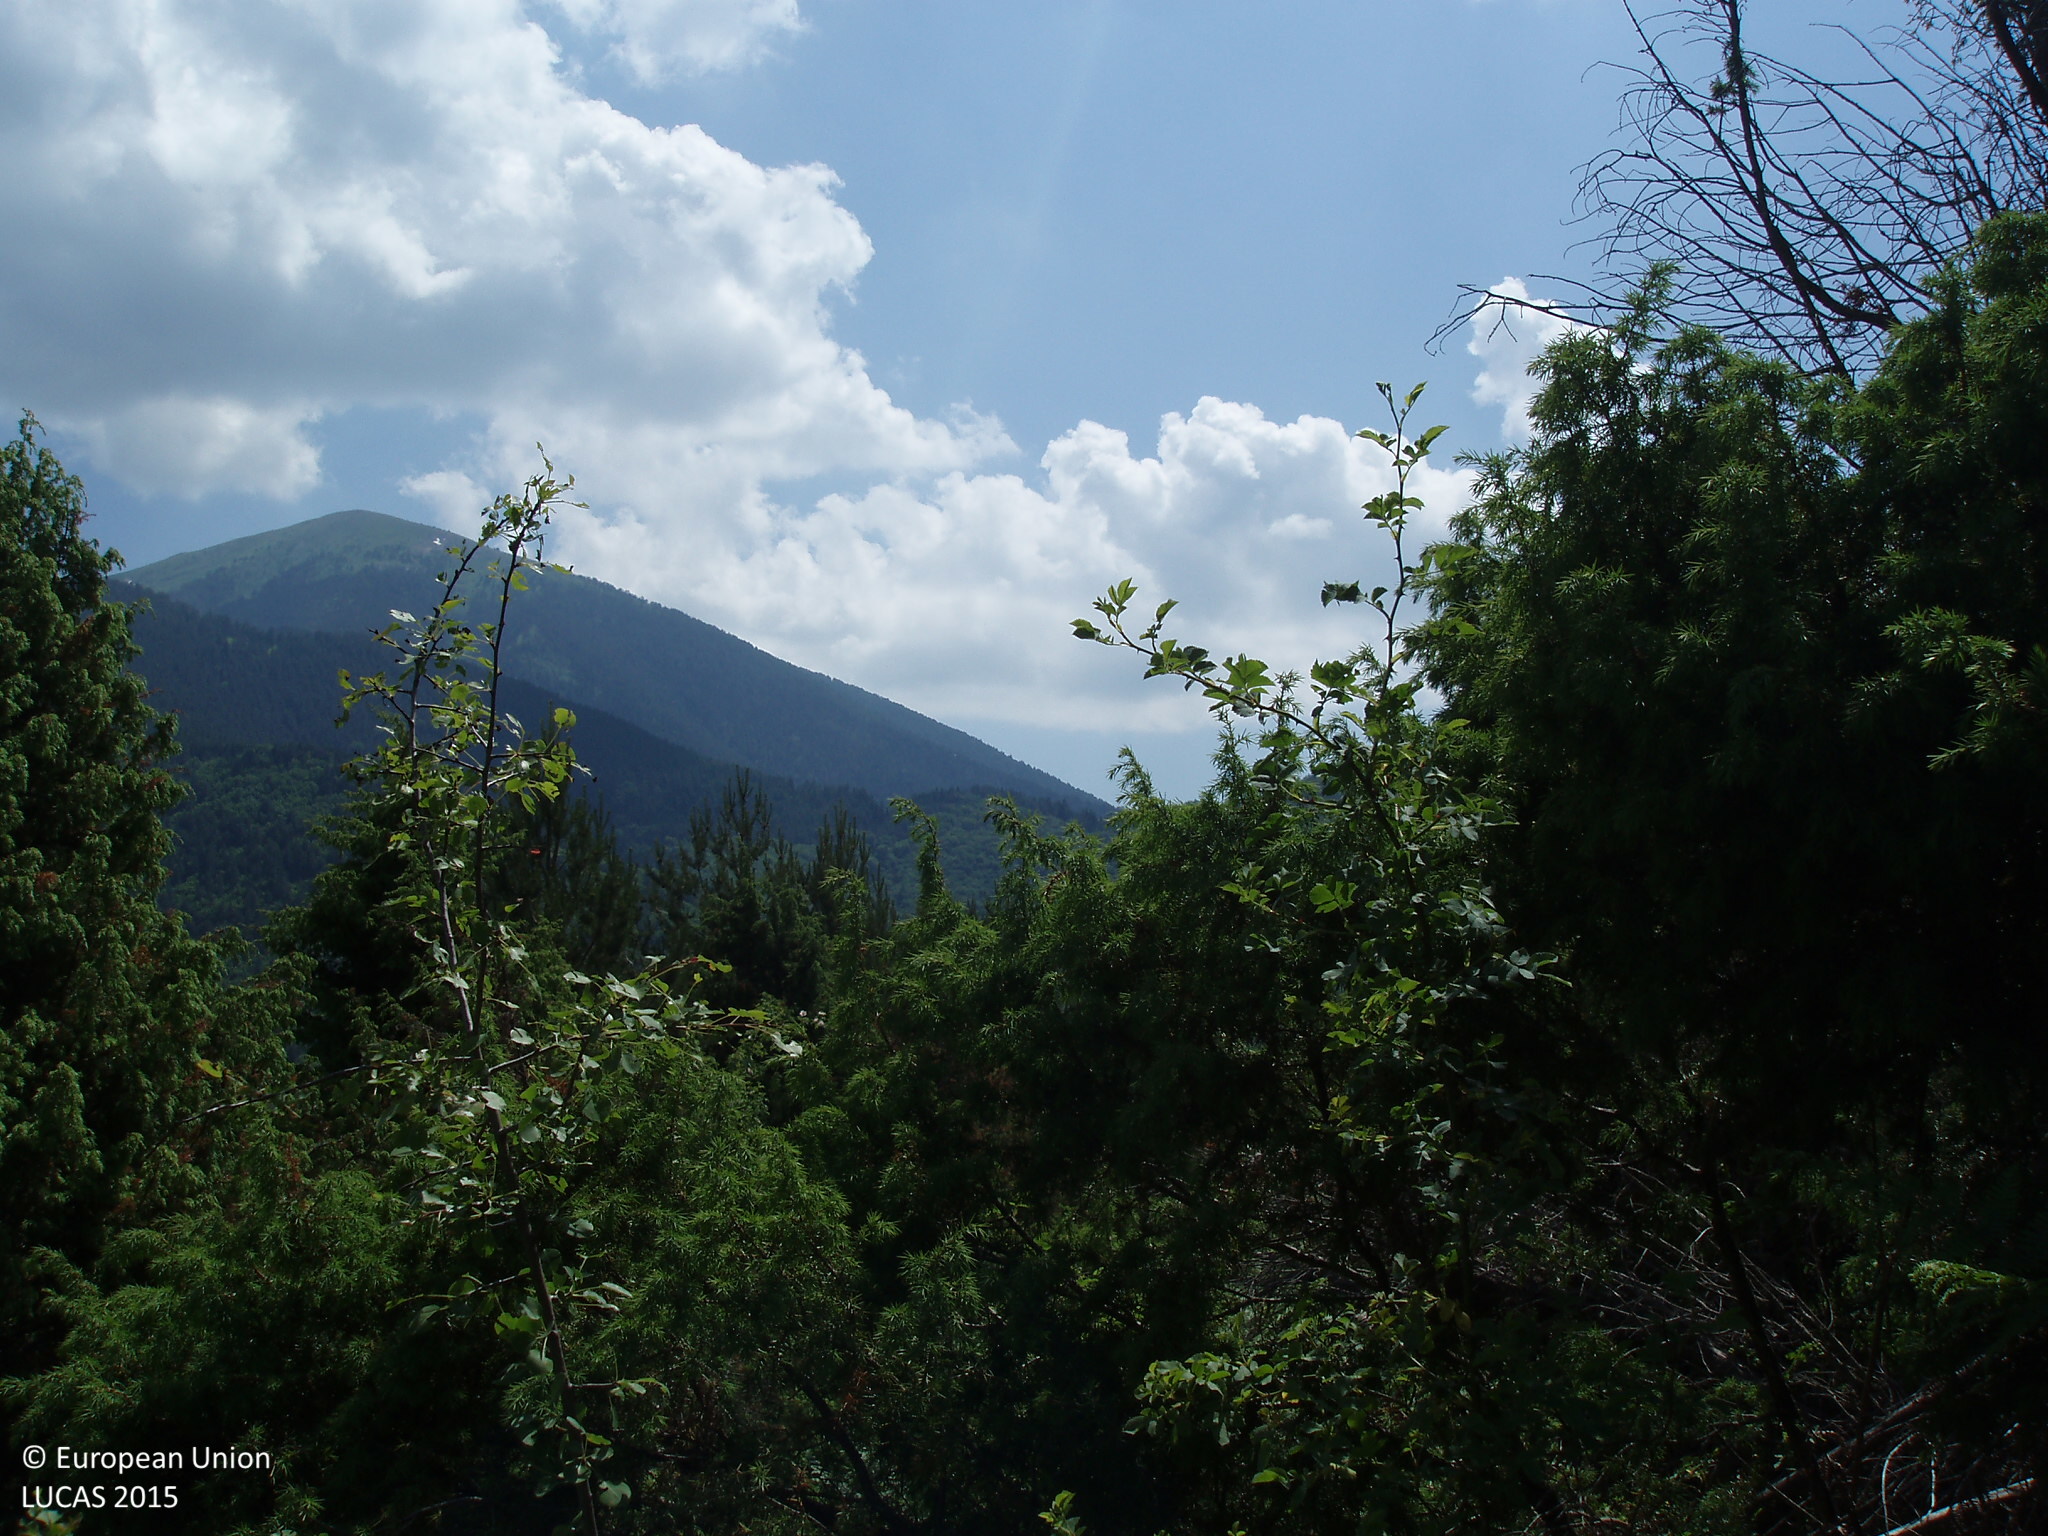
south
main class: Woodland
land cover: Other mixed woodland
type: hemiboreal forest and nemoral coniferous forest and mixed broadleaved-coniferous forest
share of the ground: > 75 %
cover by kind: coniferous forest trees 75 %, broadleaved forest trees 25 %
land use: Forestry
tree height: > 5 m
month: June
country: BG
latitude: 41.4316
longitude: 23.6558
